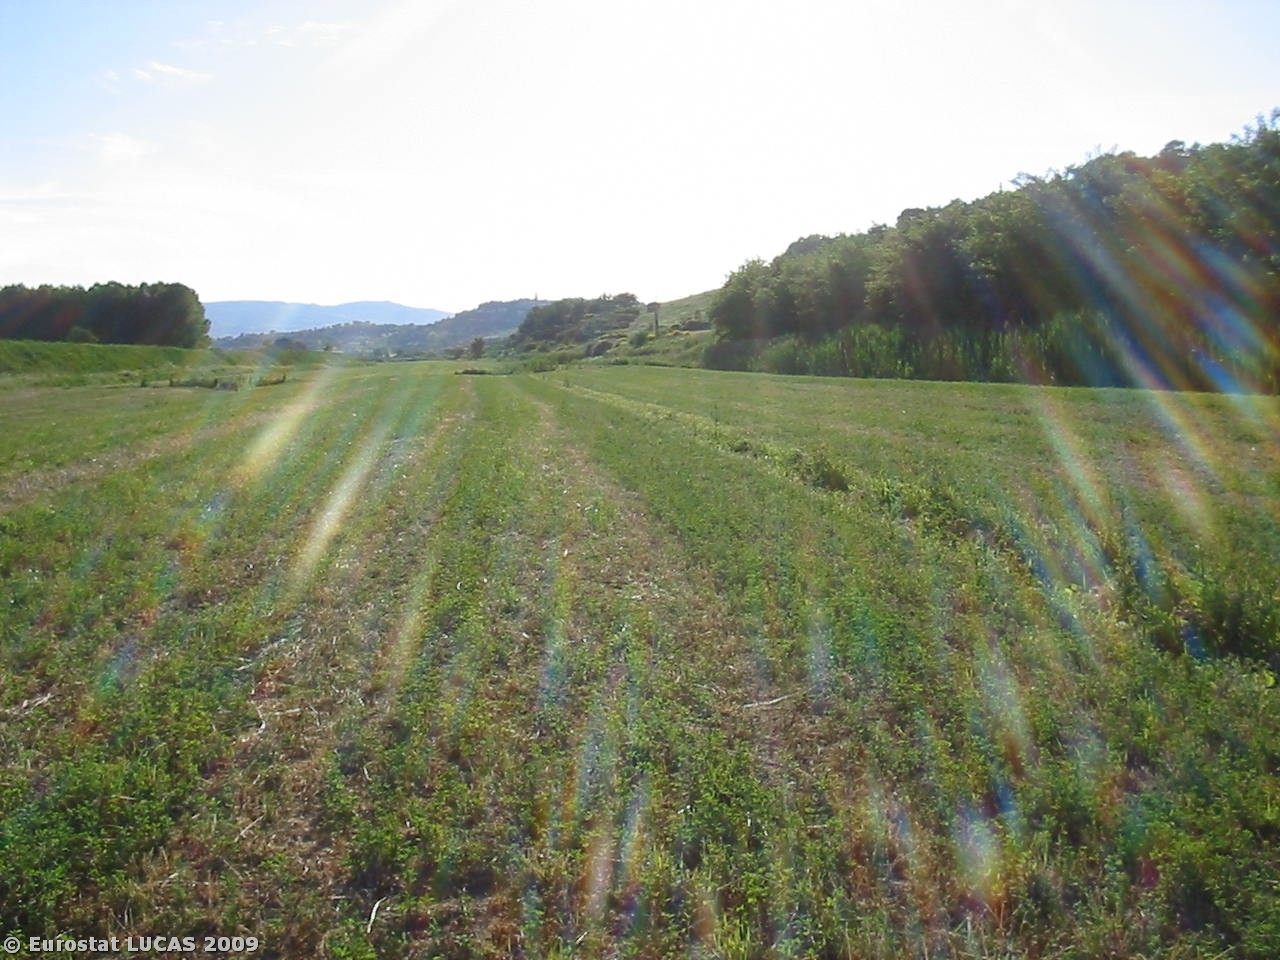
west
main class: Cropland
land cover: Lucerne
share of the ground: > 75 %
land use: Agriculture (excluding fallow land and kitchen gardens)
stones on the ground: < 10 %
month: May
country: IT
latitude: 43.0137
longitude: 11.9939
